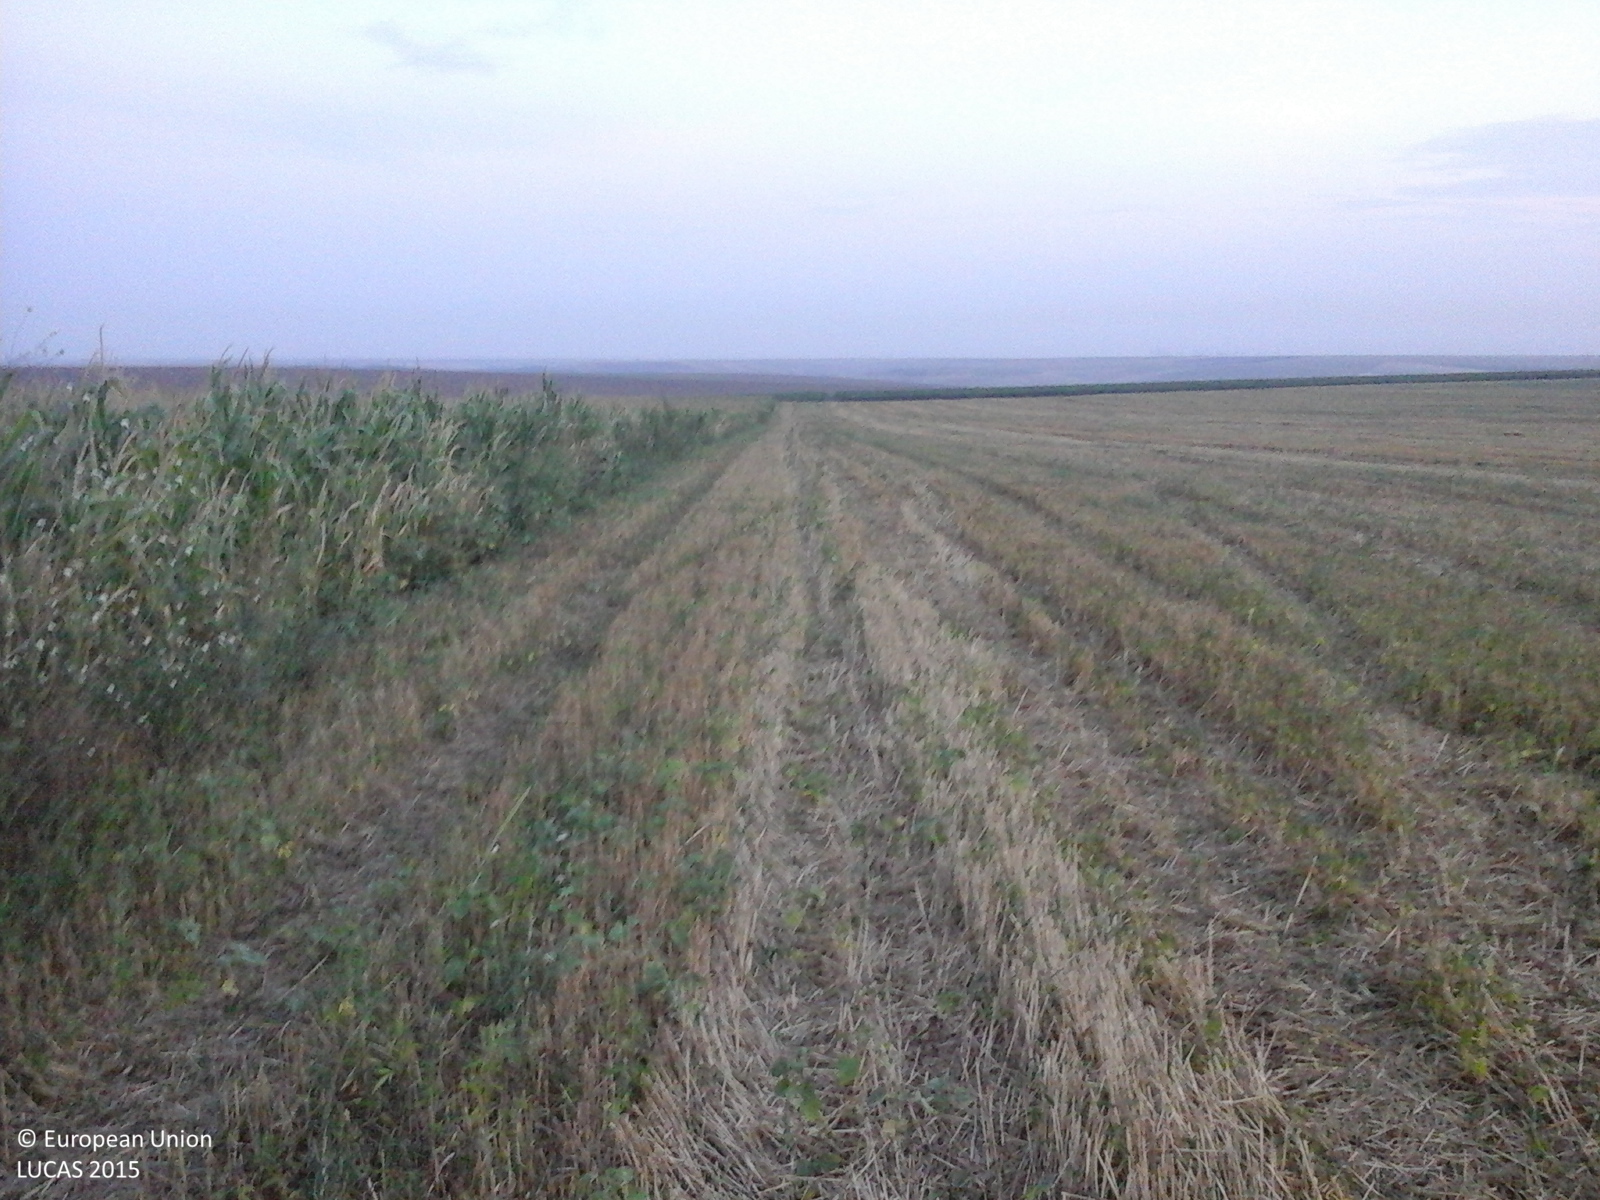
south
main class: Cropland
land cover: Maize
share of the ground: > 75 %
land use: Agriculture (excluding fallow land and kitchen gardens)
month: August
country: RO
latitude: 44.2325
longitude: 28.1245
